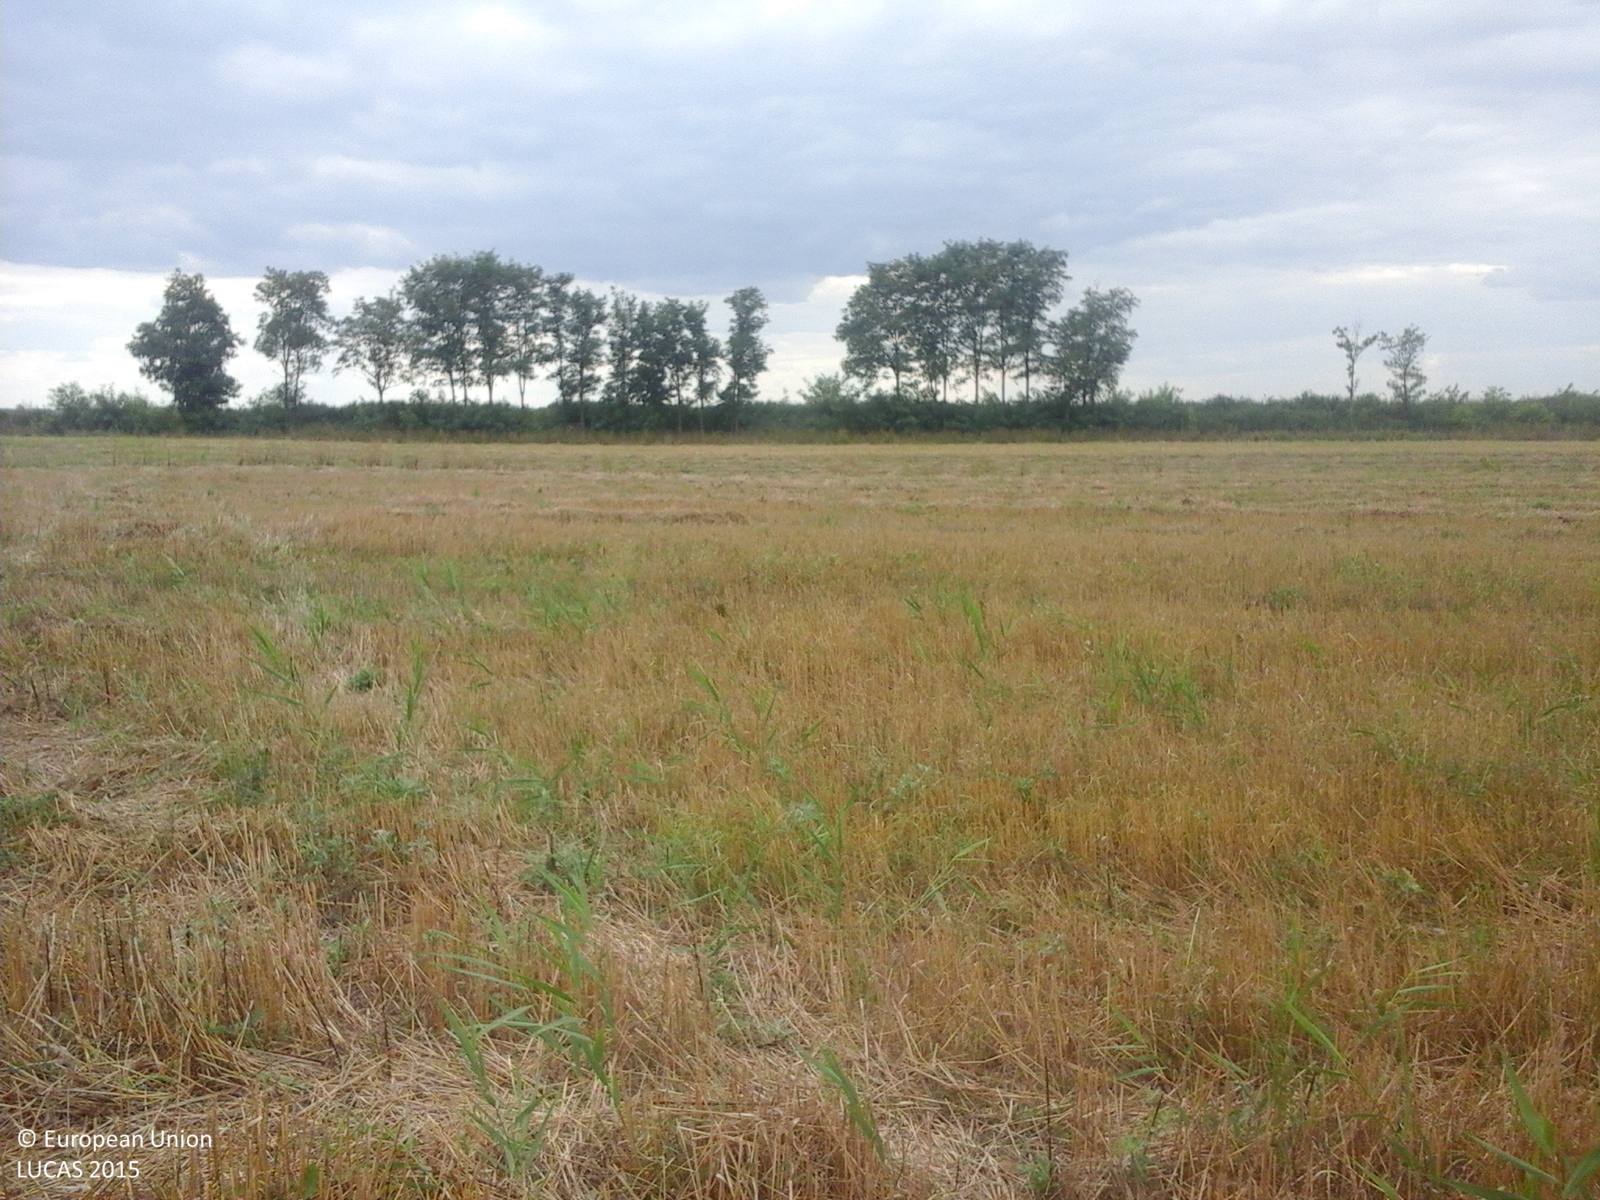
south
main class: Cropland
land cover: Common wheat
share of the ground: > 75 %
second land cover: Spontaneously vegetated surfaces
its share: 25 - 50 %
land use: Agriculture (excluding fallow land and kitchen gardens)
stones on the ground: < 10 %
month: September
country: RO
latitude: 47.8769
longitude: 22.7792
